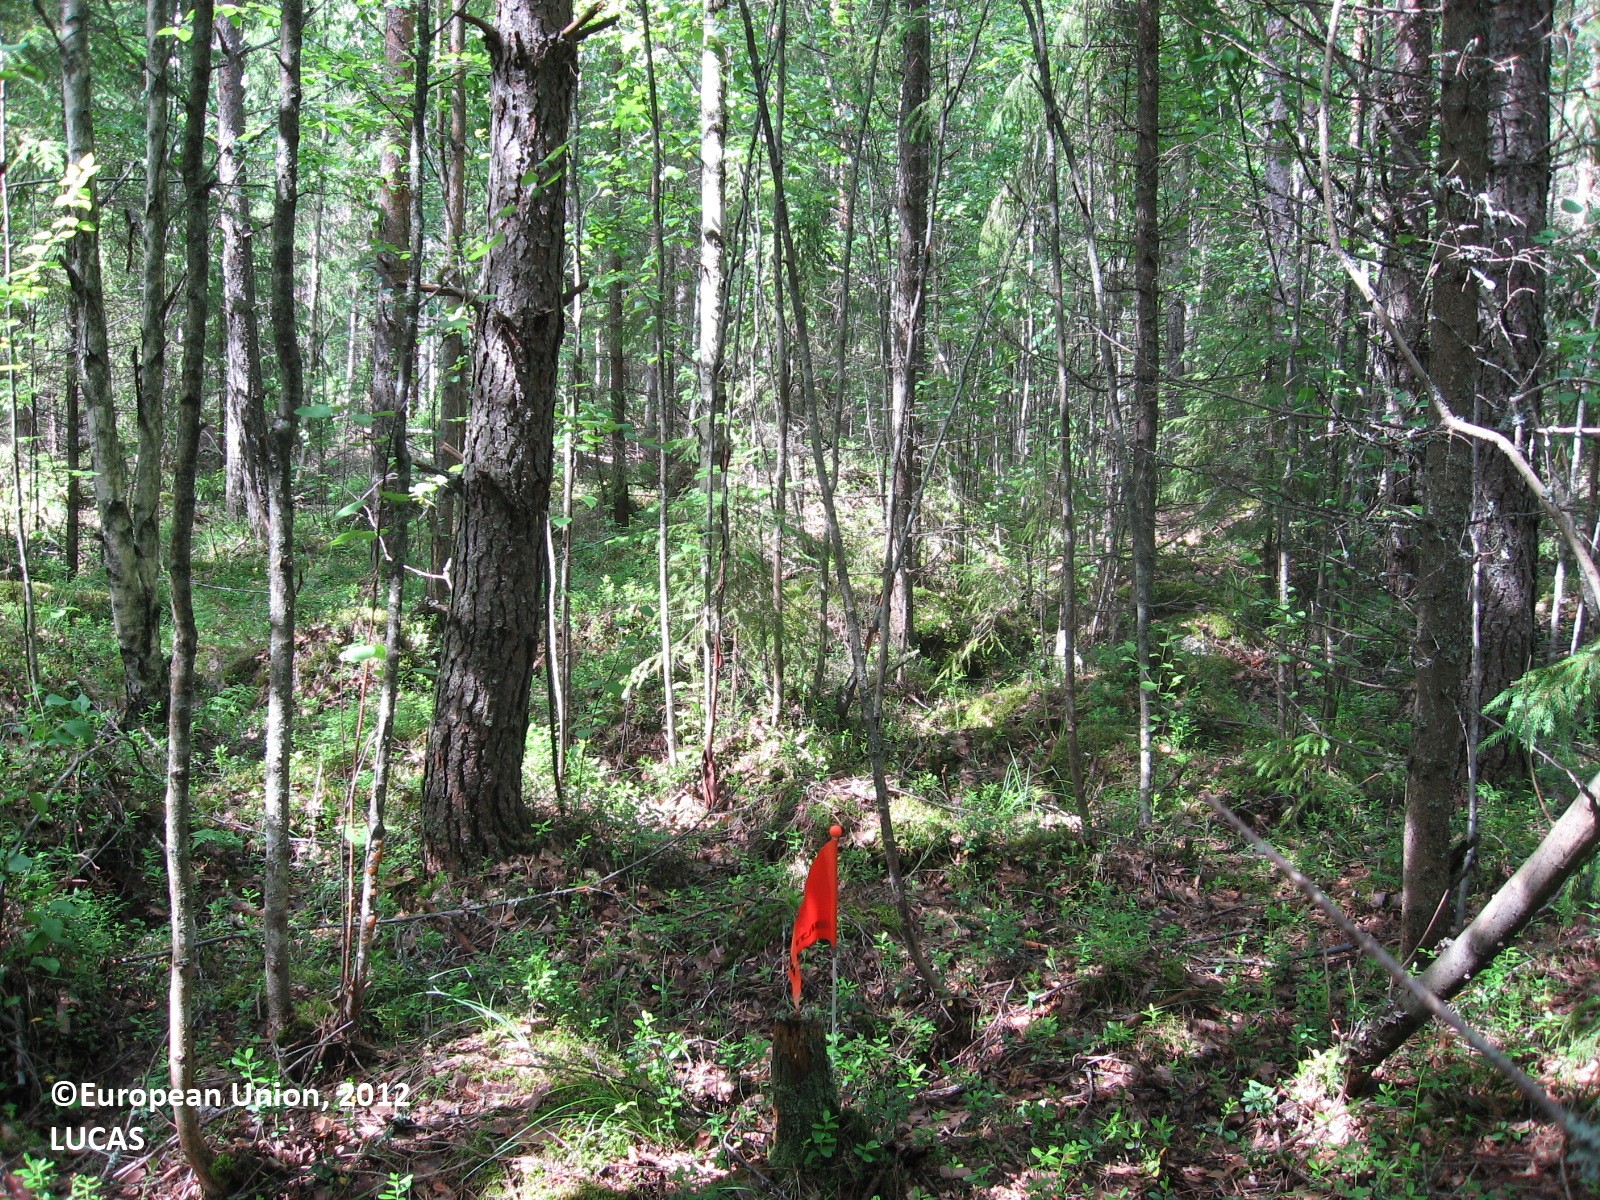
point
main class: Woodland
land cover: Spruce dominated mixed woodland
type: boreal forest
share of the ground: > 75 %
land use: Forestry
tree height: > 5 m
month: June
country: FI
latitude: 60.5522
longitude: 26.2875
